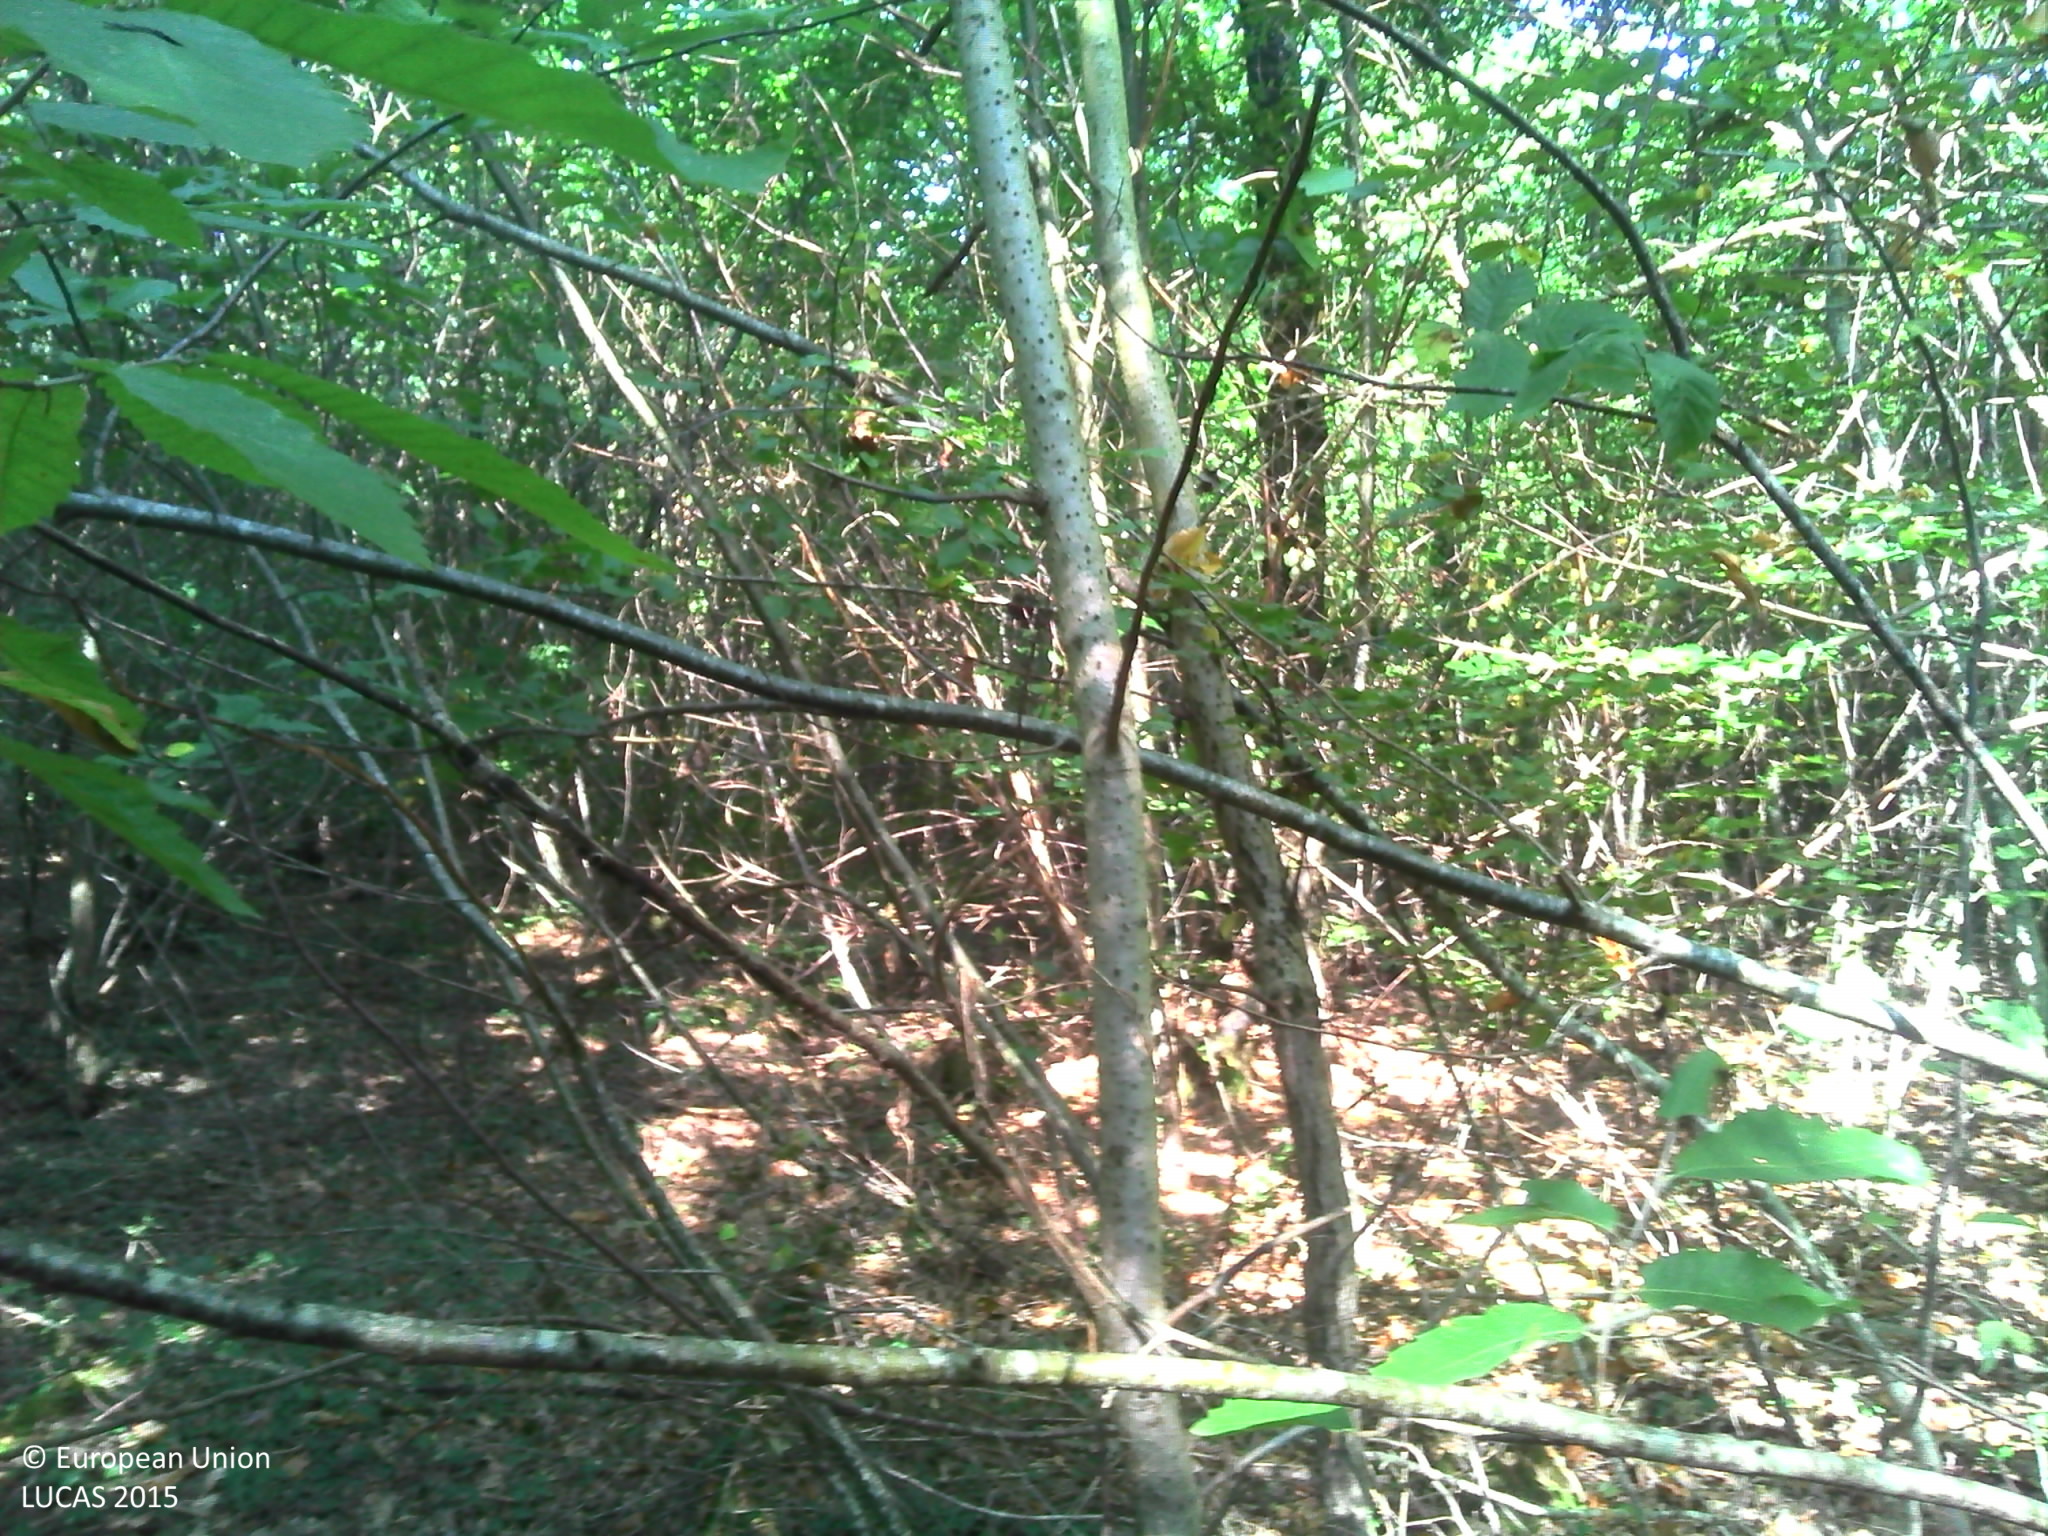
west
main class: Woodland
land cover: Broadleaved woodland
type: mesophytic deciduous forest
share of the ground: > 75 %
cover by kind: broadleaved forest trees 95 %, unconsolidated bare surface 5 %
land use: Forestry
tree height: > 5 m
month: September
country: FR
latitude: 47.0400
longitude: 1.4459
